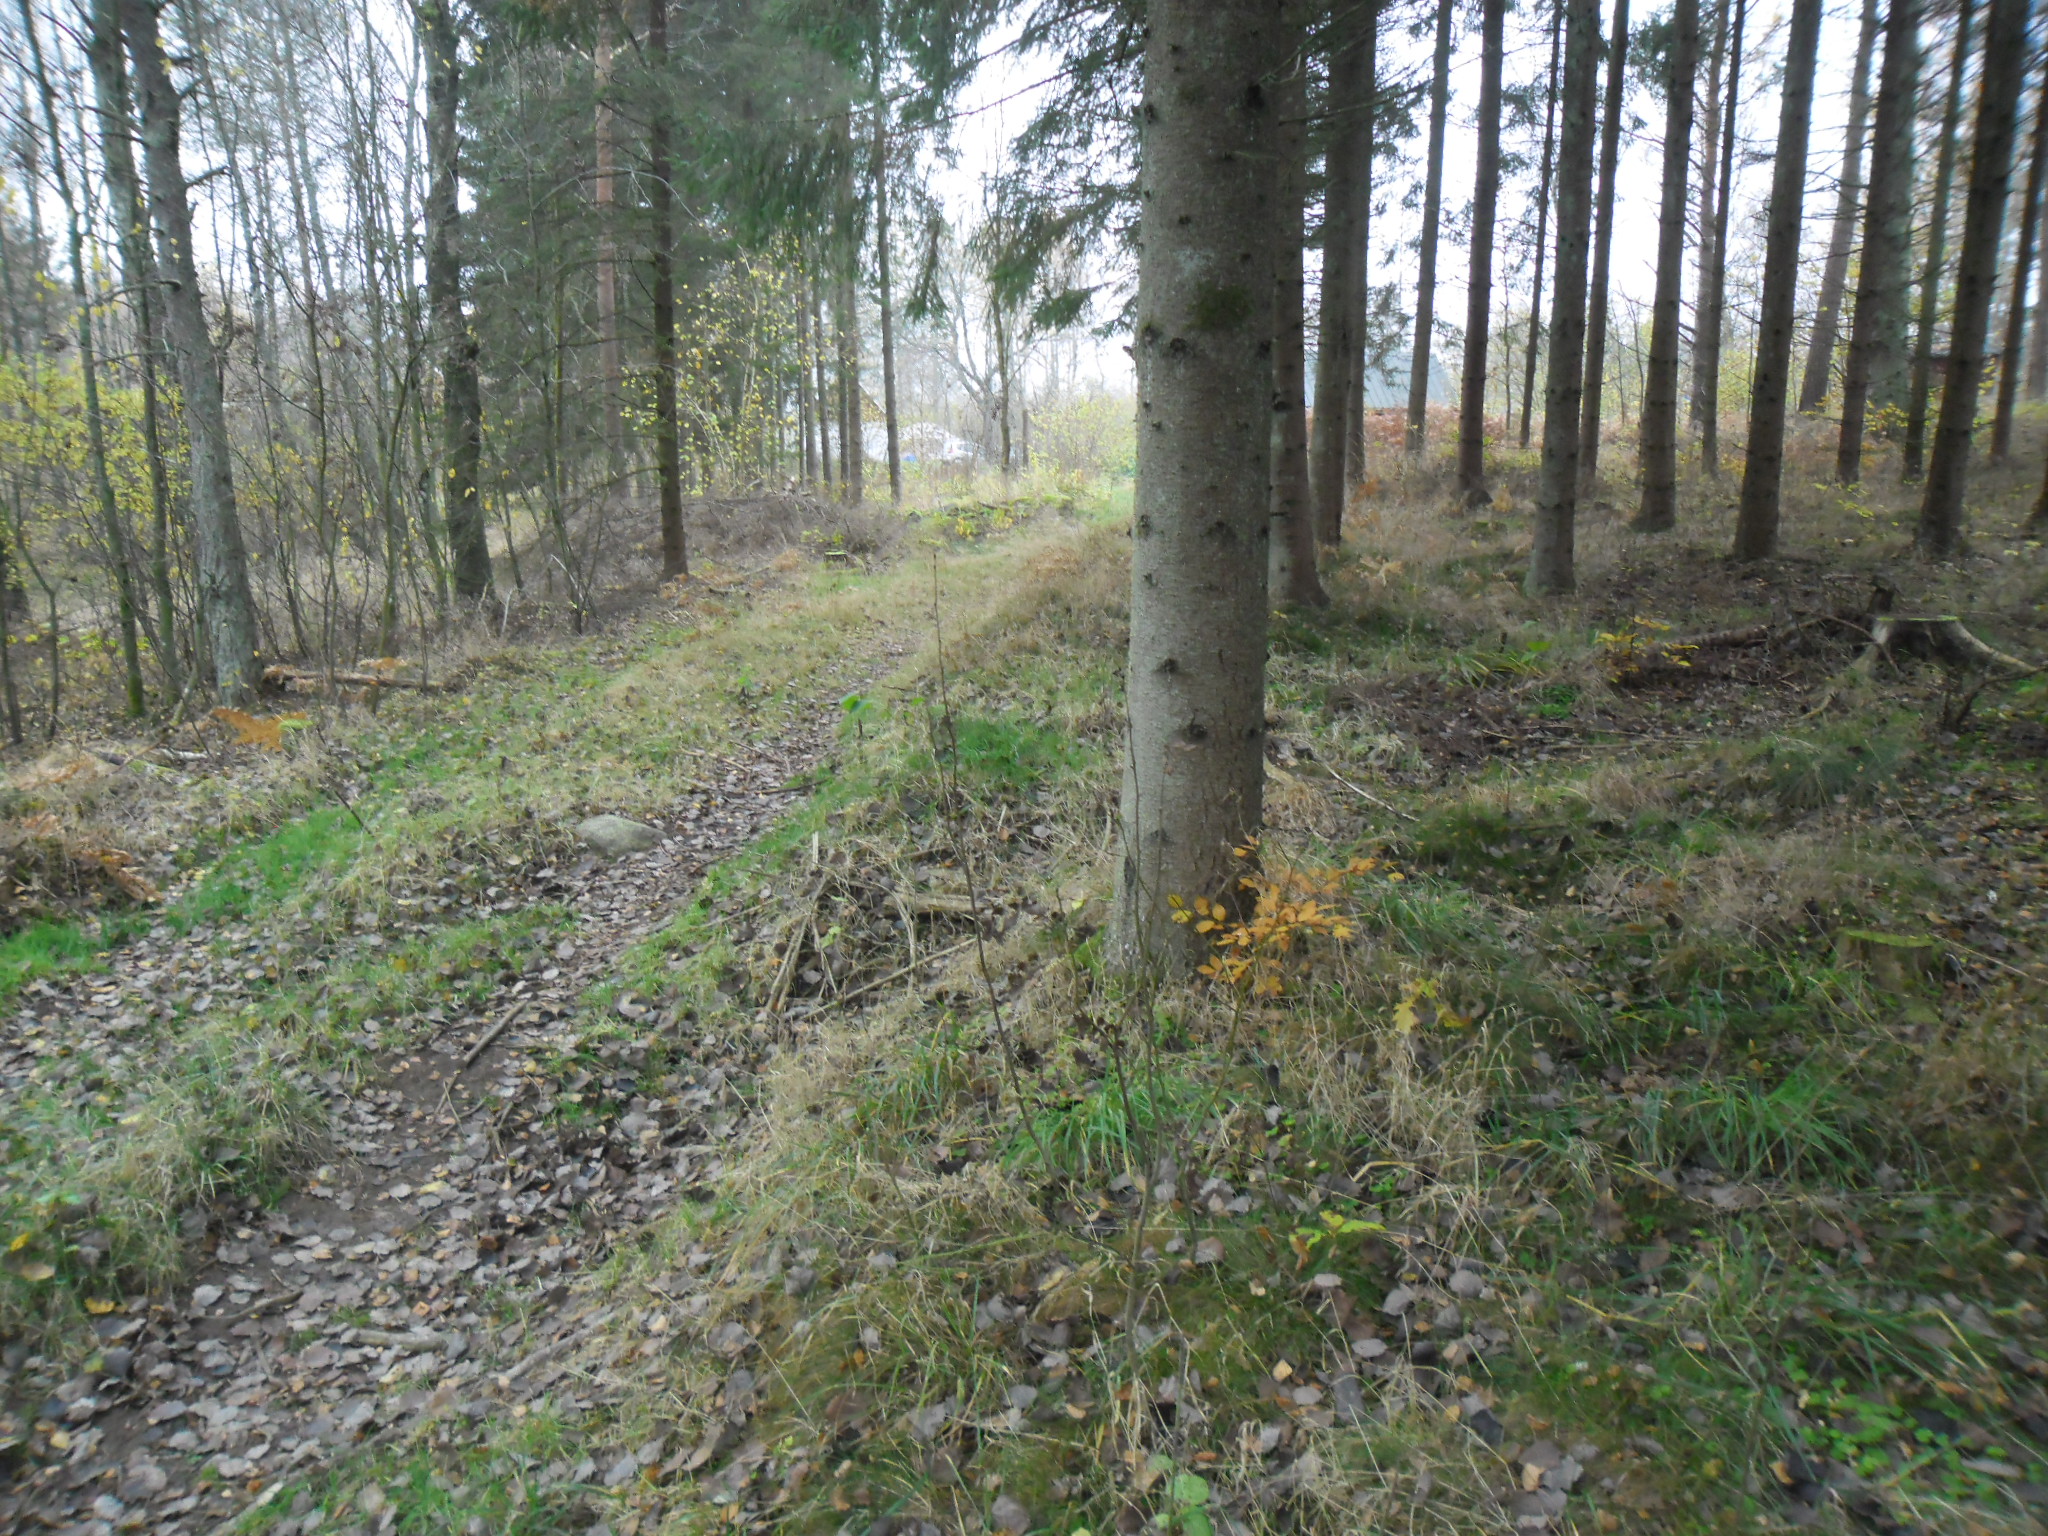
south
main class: Grassland
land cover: Grassland without tree/shrub cover
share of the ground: > 75 %
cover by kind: herbaceous plants 100 %
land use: Agriculture (excluding fallow land and kitchen gardens)
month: November
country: SE
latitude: 56.2767
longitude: 13.0820
